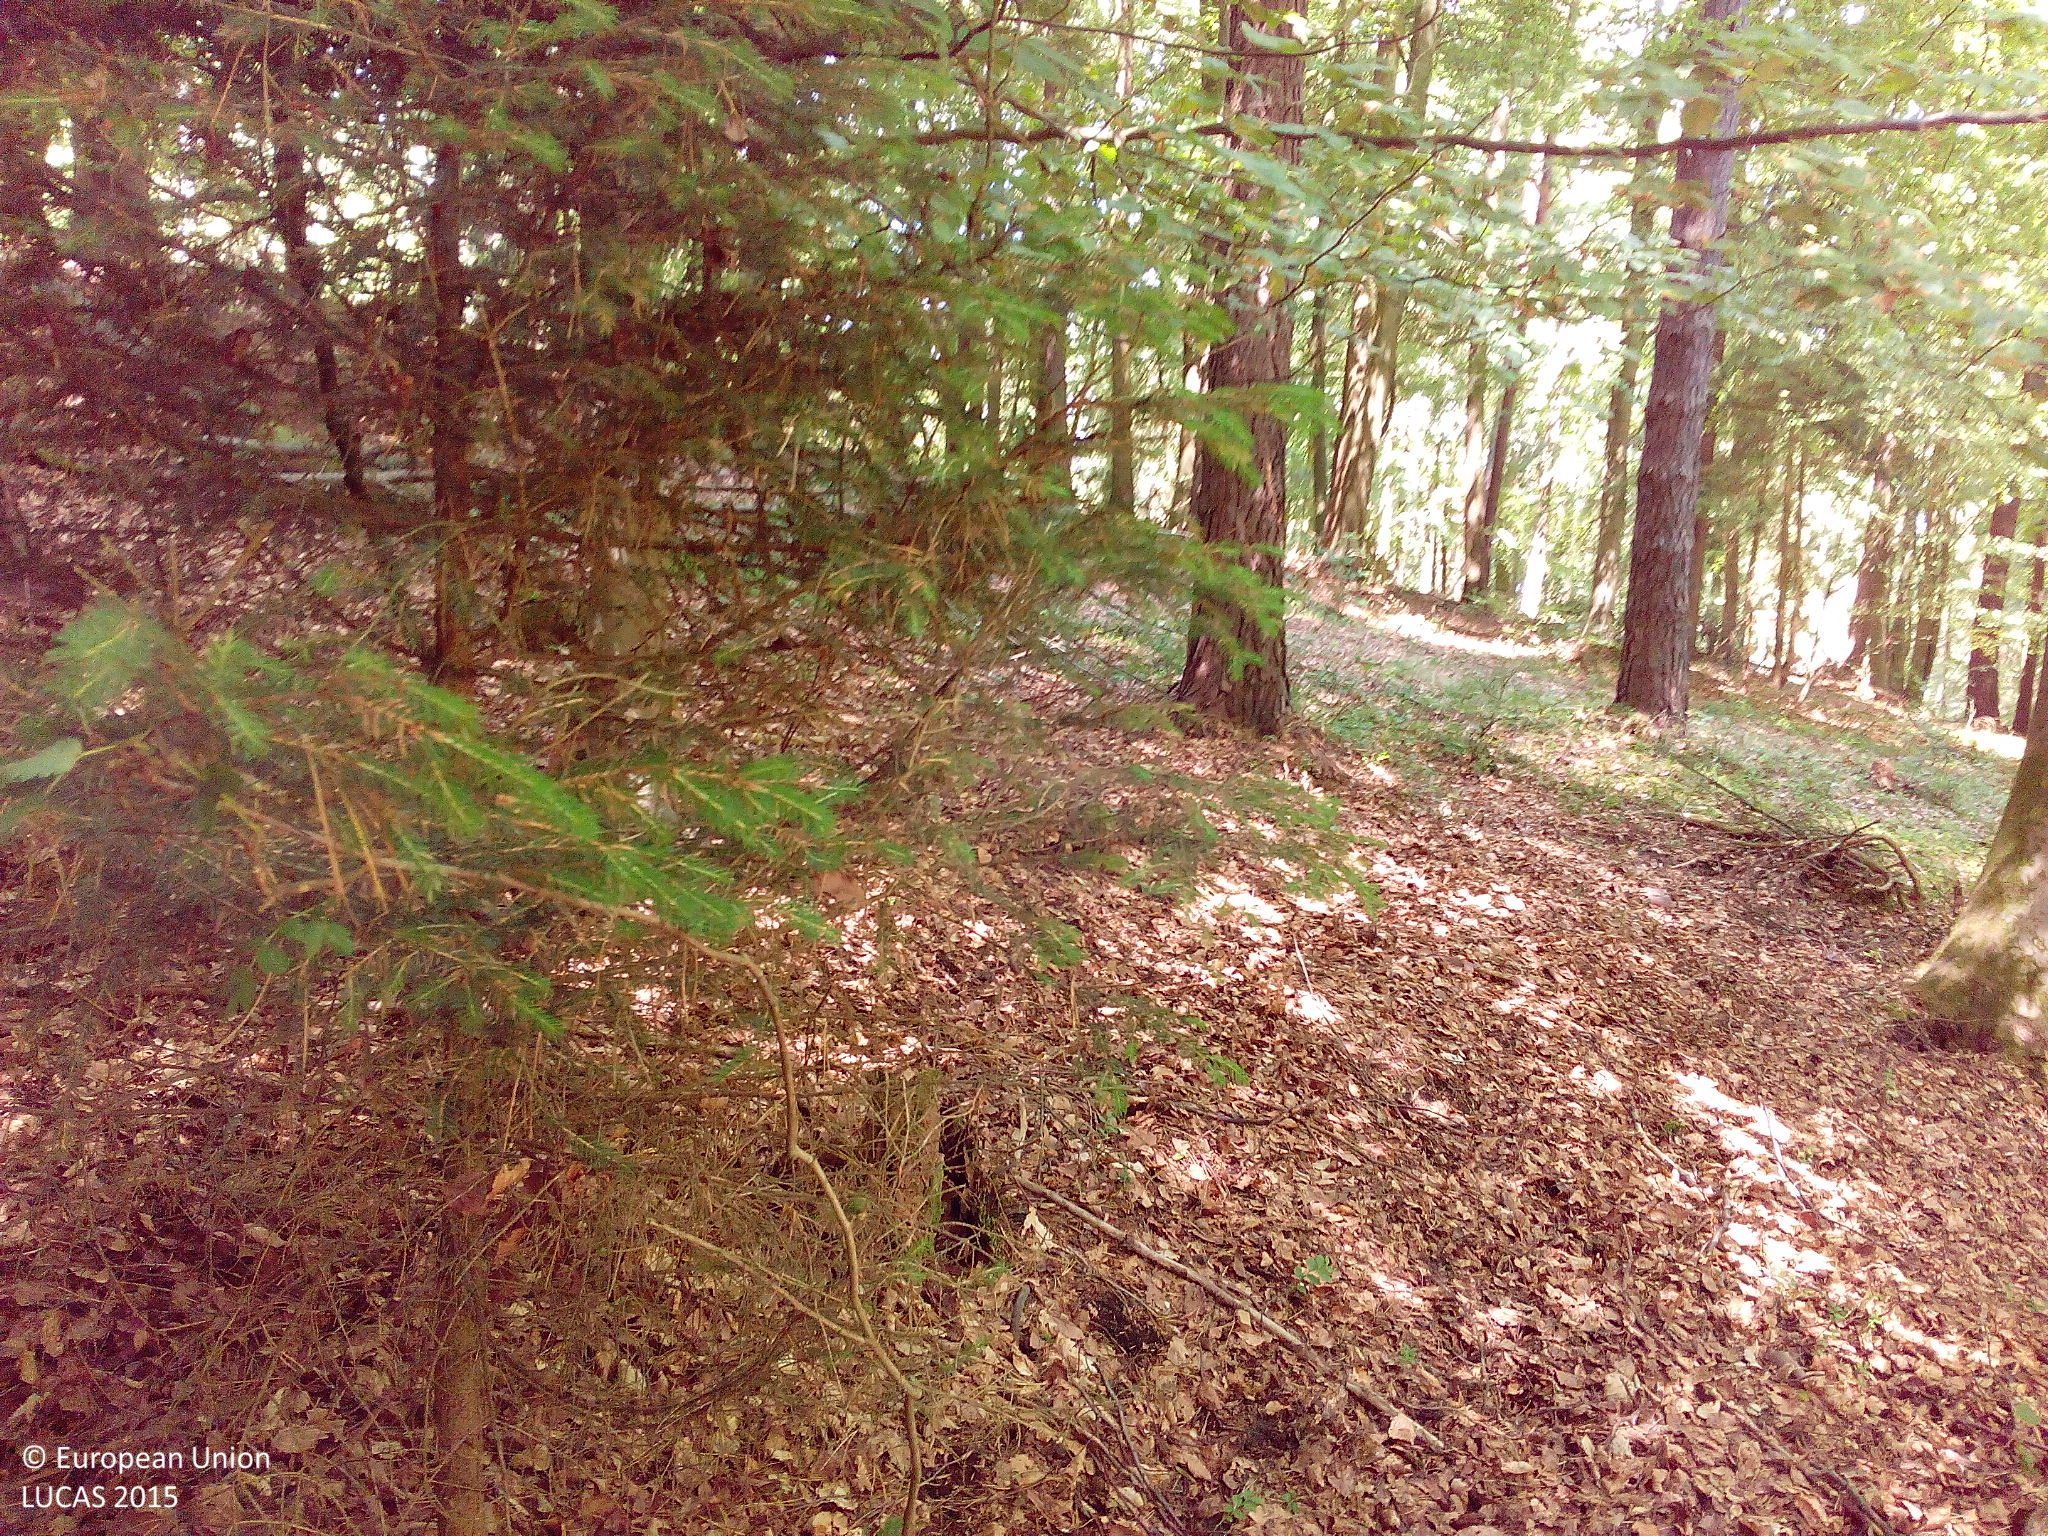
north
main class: Woodland
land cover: Pine dominated mixed woodland
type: hemiboreal forest and nemoral coniferous forest and mixed broadleaved-coniferous forest
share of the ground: > 75 %
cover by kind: coniferous forest trees 50 %, broadleaved forest trees 50 %
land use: Forestry
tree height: > 5 m
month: July
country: DE
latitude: 50.9214
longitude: 9.9573
